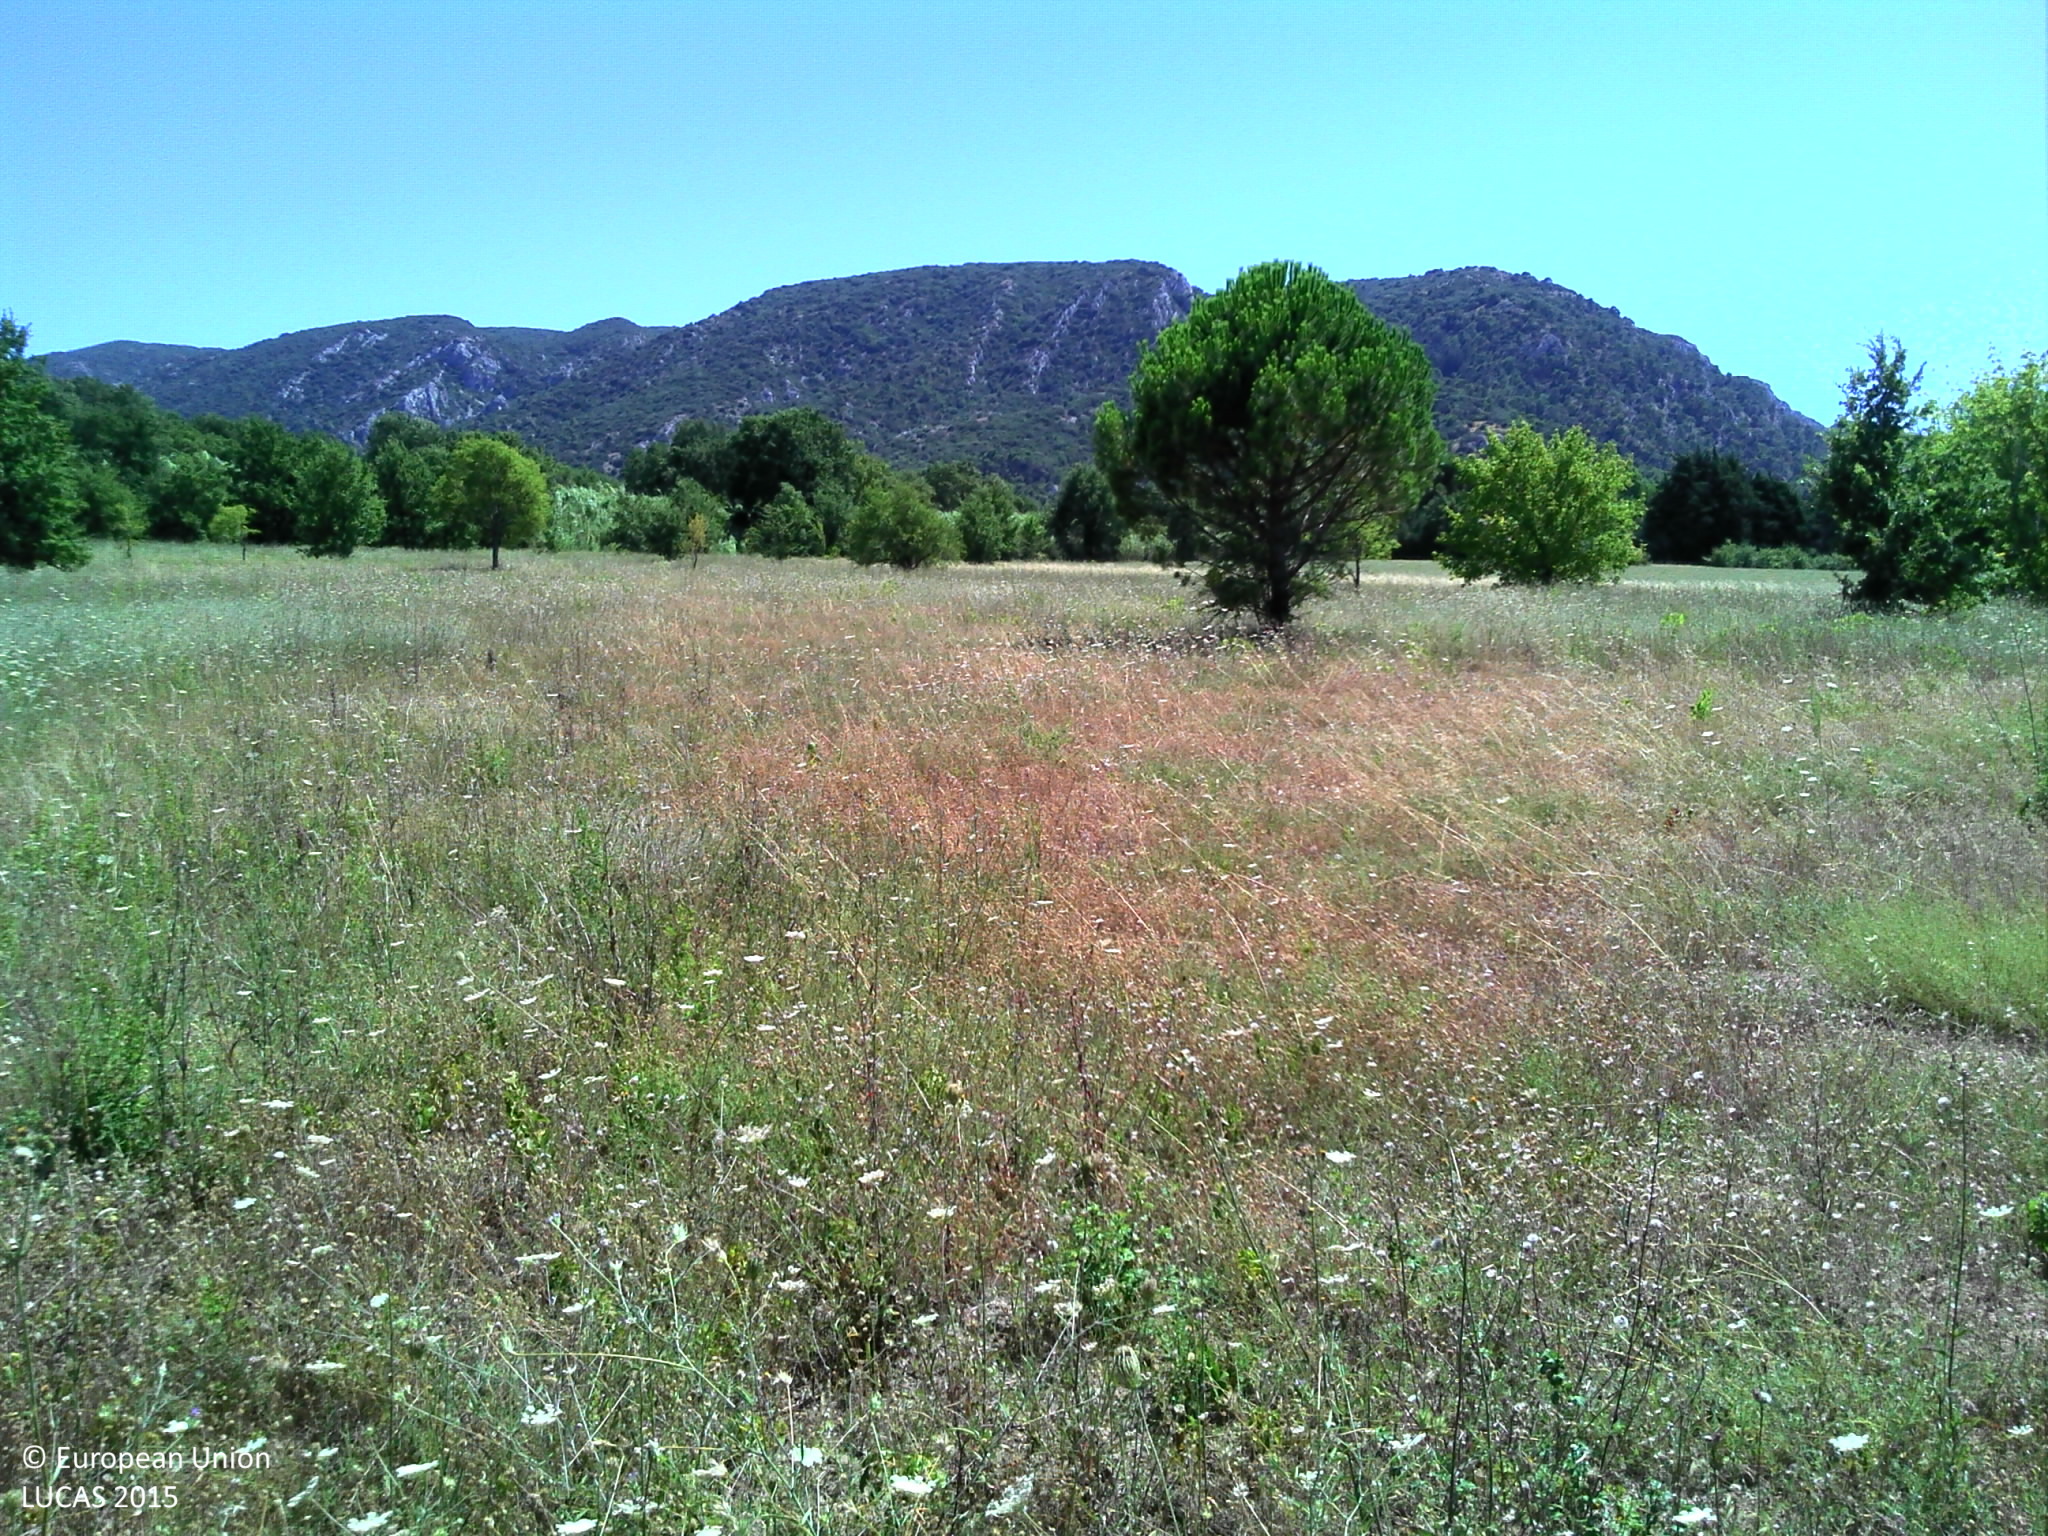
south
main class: Grassland
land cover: Grassland with sparse tree/shrub cover
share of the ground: > 75 %
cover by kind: herbaceous plants 90 %, broadleaved forest trees 5 %, shrubs 5 %
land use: Semi-natural and natural areas not in use
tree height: < 5 m
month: July
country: FR
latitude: 43.8563
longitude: 5.1196
